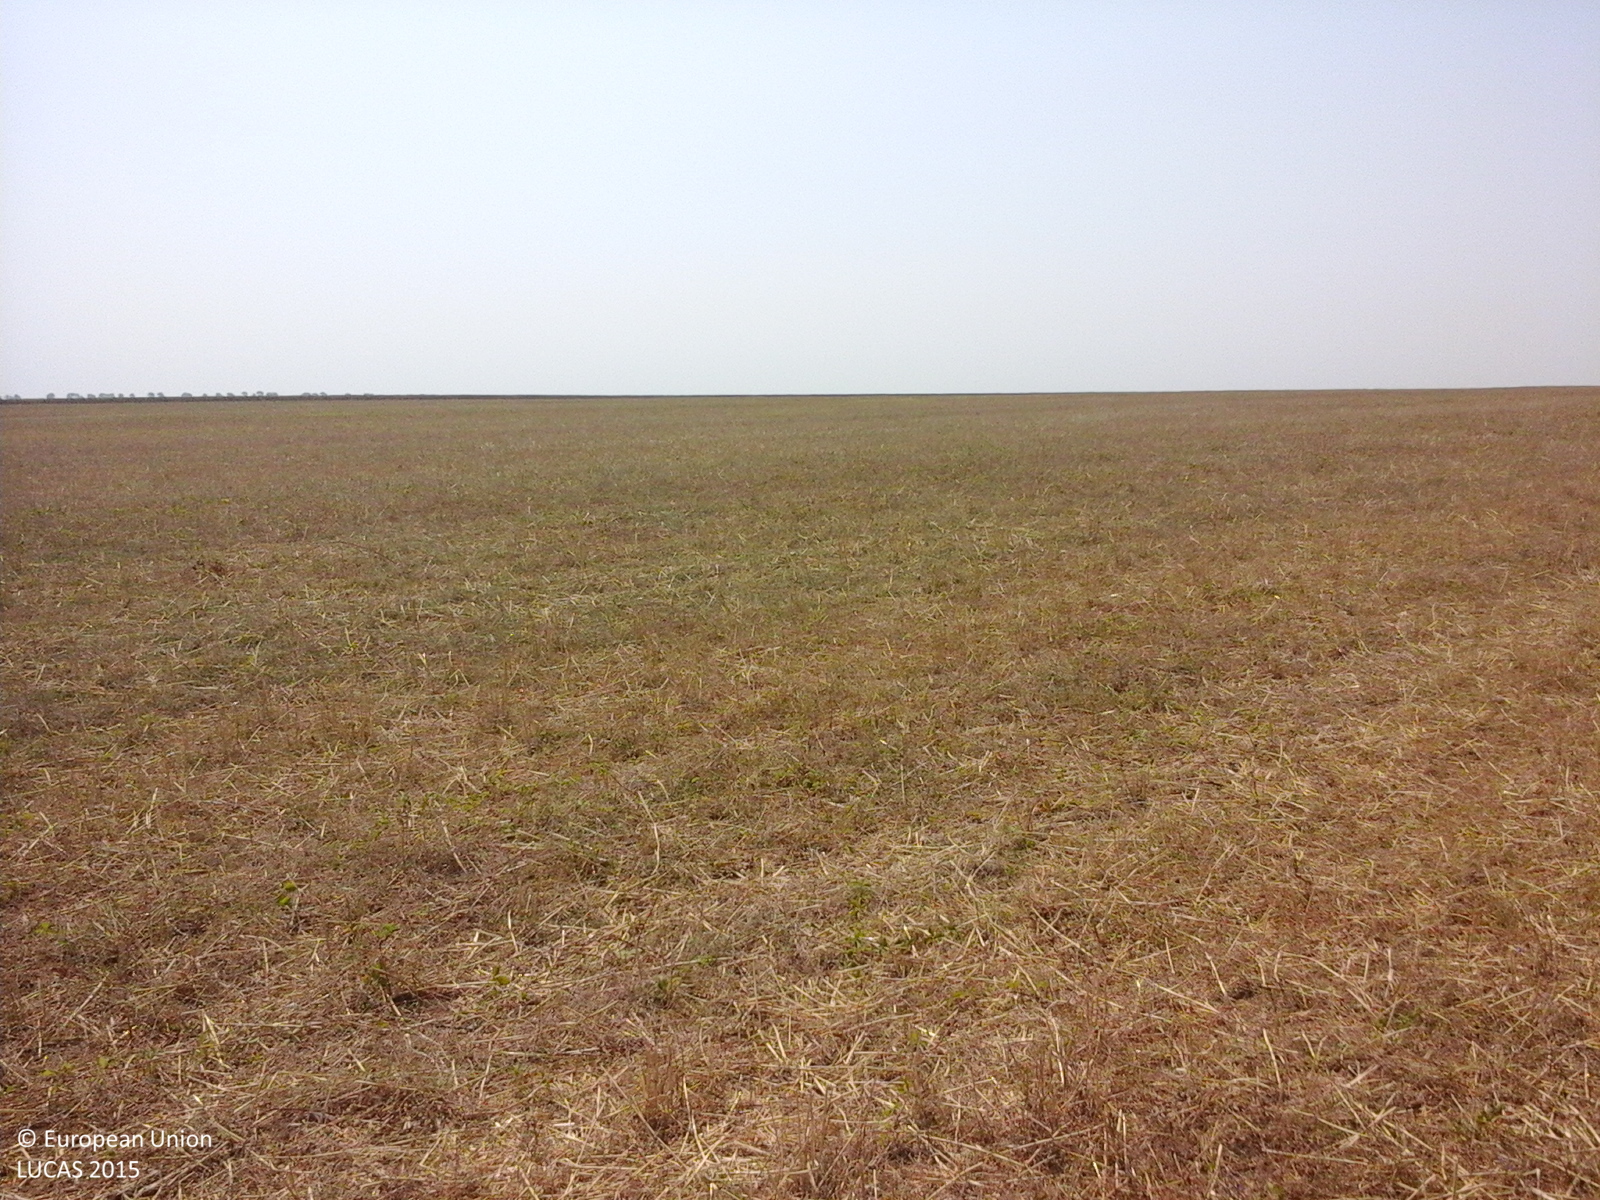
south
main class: Cropland
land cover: Common wheat
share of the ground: 50 - 75 %
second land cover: Spontaneously vegetated surfaces
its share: 50 - 75 %
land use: Agriculture (excluding fallow land and kitchen gardens)
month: August
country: RO
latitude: 44.2264
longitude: 23.2542
